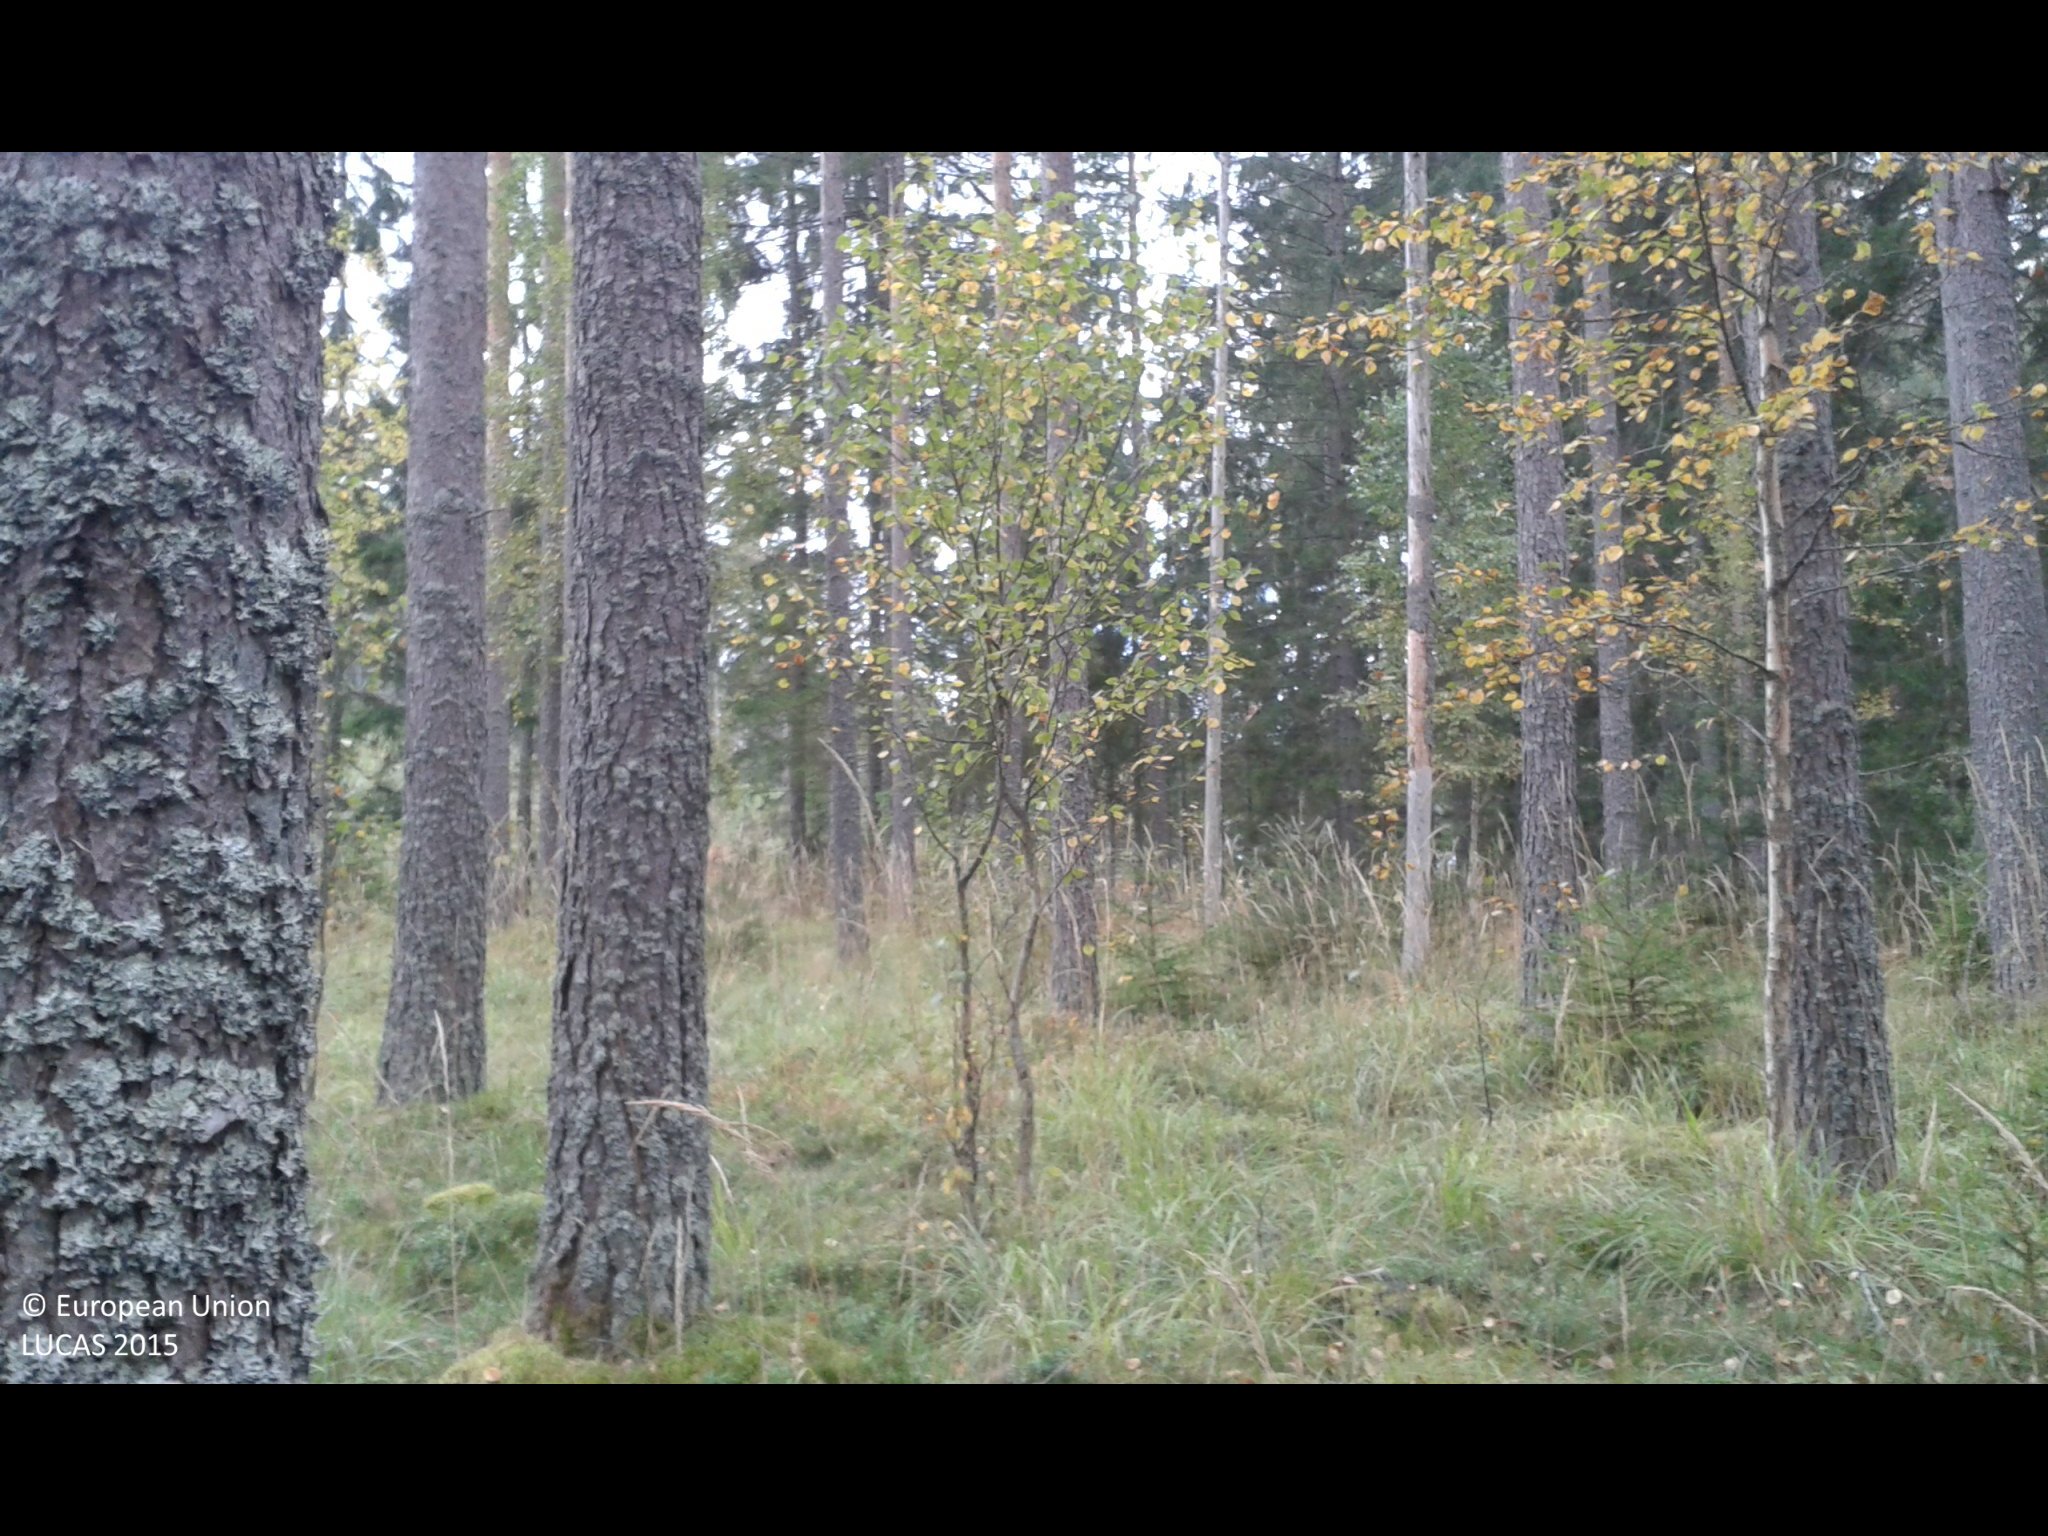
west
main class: Woodland
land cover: Pine dominated coniferous woodland
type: boreal forest
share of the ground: 50 - 75 %
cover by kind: herbaceous plants 50 %, coniferous forest trees 45 %, broadleaved forest trees 5 %
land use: Forestry
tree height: > 5 m
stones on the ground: < 10 %
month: September
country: SE
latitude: 59.0437
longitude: 17.4396
